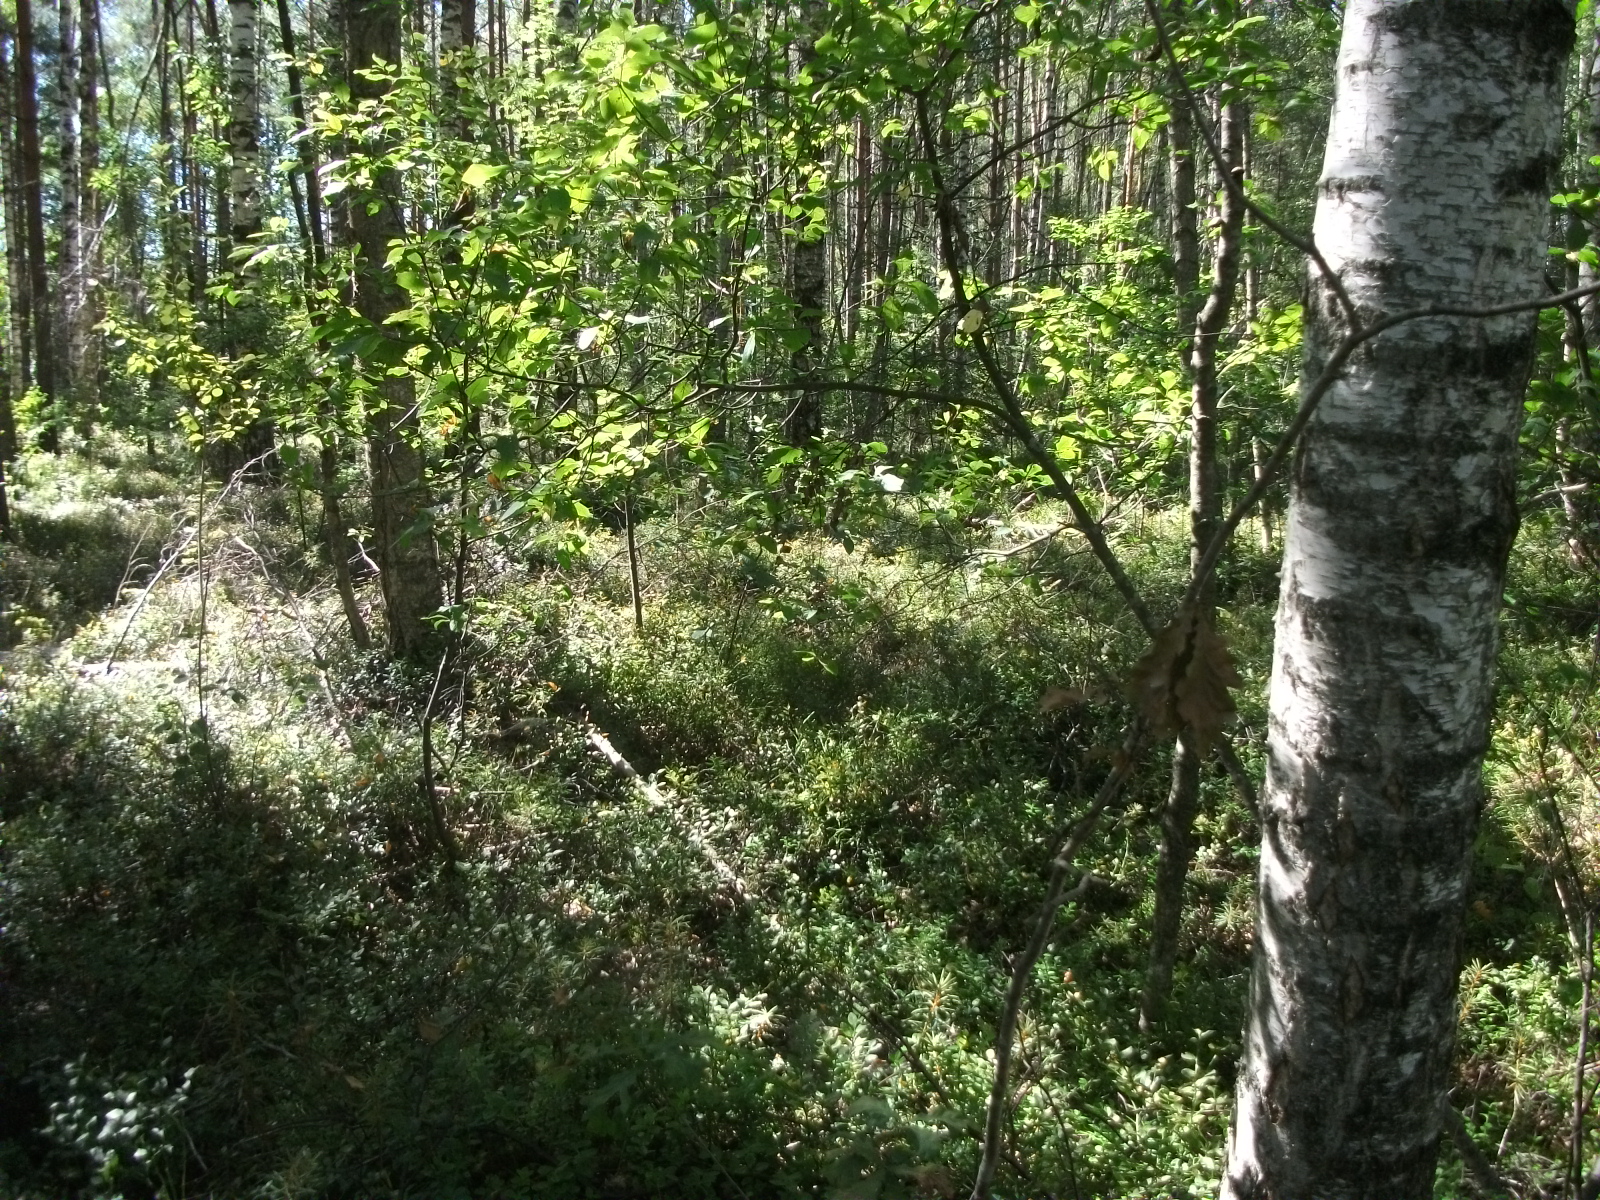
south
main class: Woodland
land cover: Pine dominated mixed woodland
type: hemiboreal forest and nemoral coniferous forest and mixed broadleaved-coniferous forest
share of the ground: > 75 %
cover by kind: broadleaved forest trees 55 %, coniferous forest trees 30 %, herbaceous plants 10 %, lichens and mosses 5 %
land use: Forestry
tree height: > 5 m
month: August
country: LV
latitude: 56.6779
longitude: 26.3166
